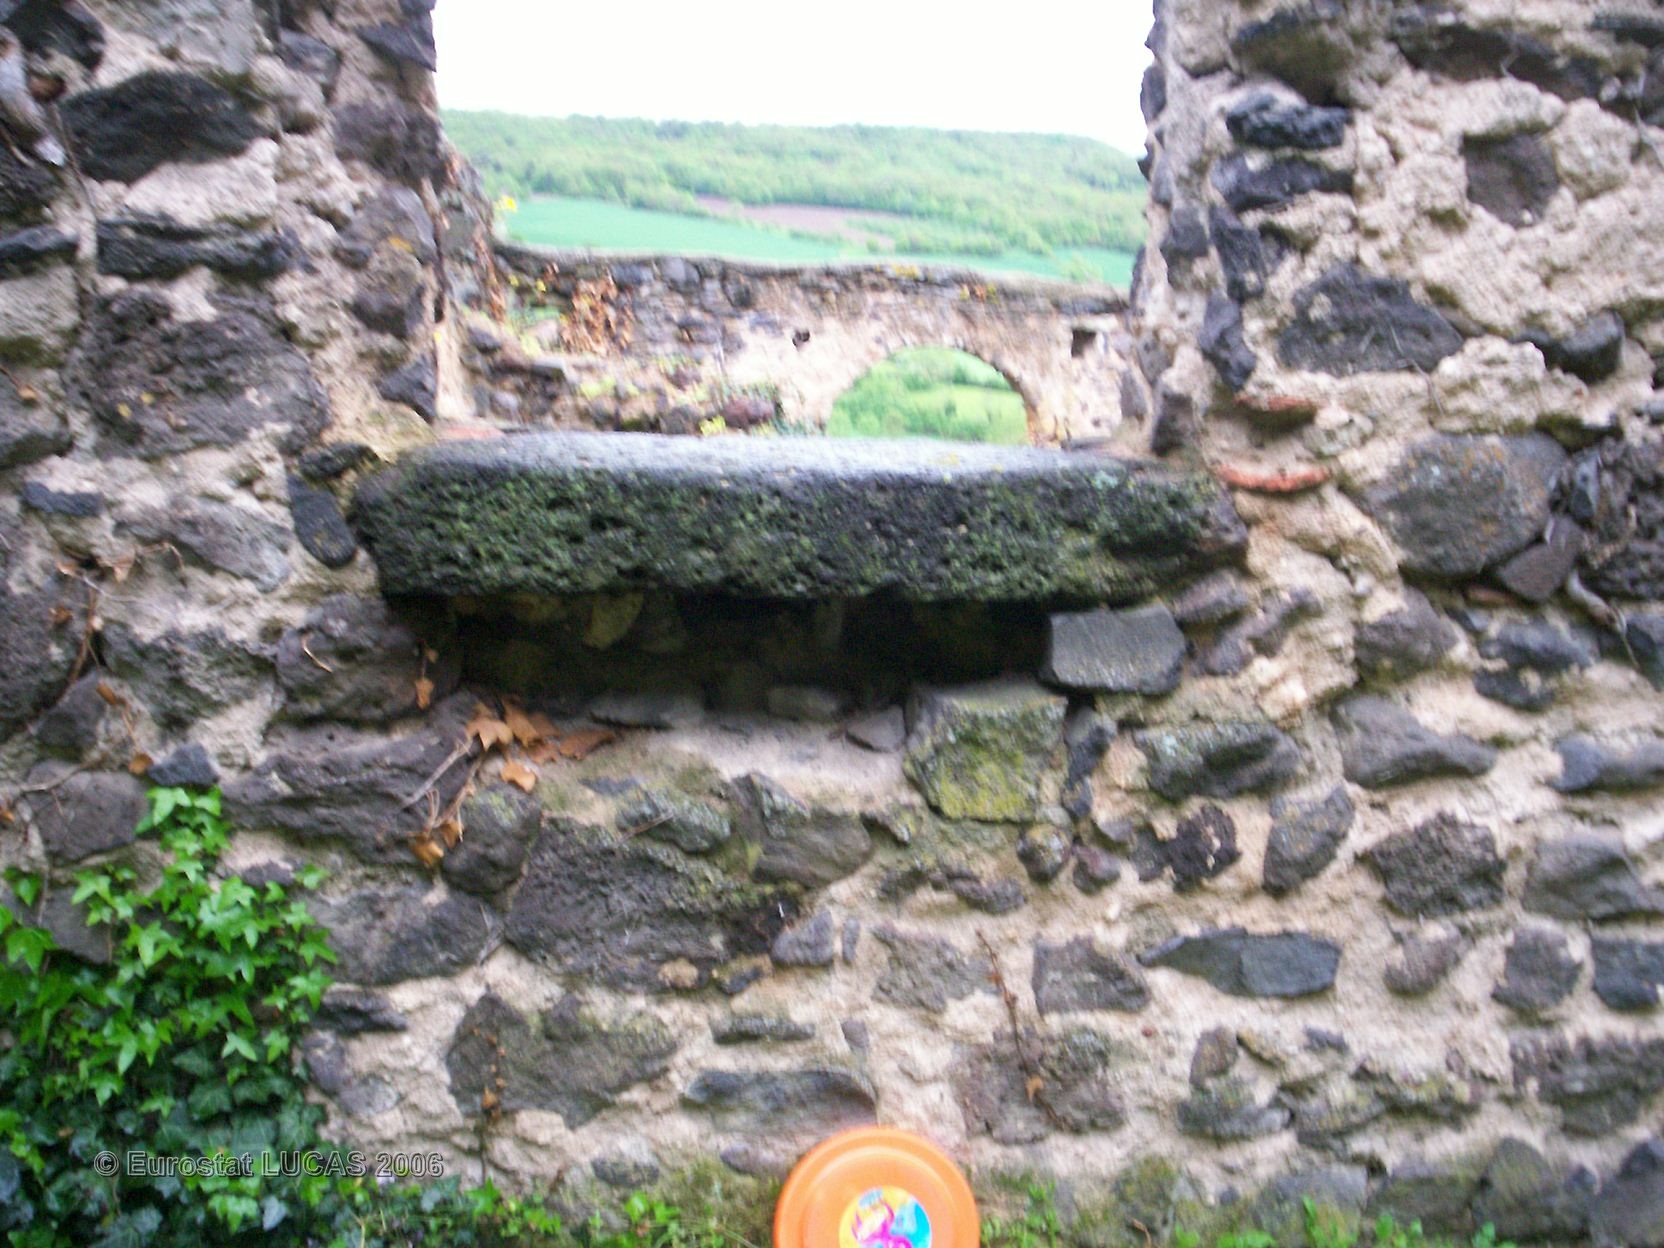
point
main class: Grassland
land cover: Grassland without tree/shrub cover
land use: Unused
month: May
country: FR
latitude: 45.4665
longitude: 3.2096
